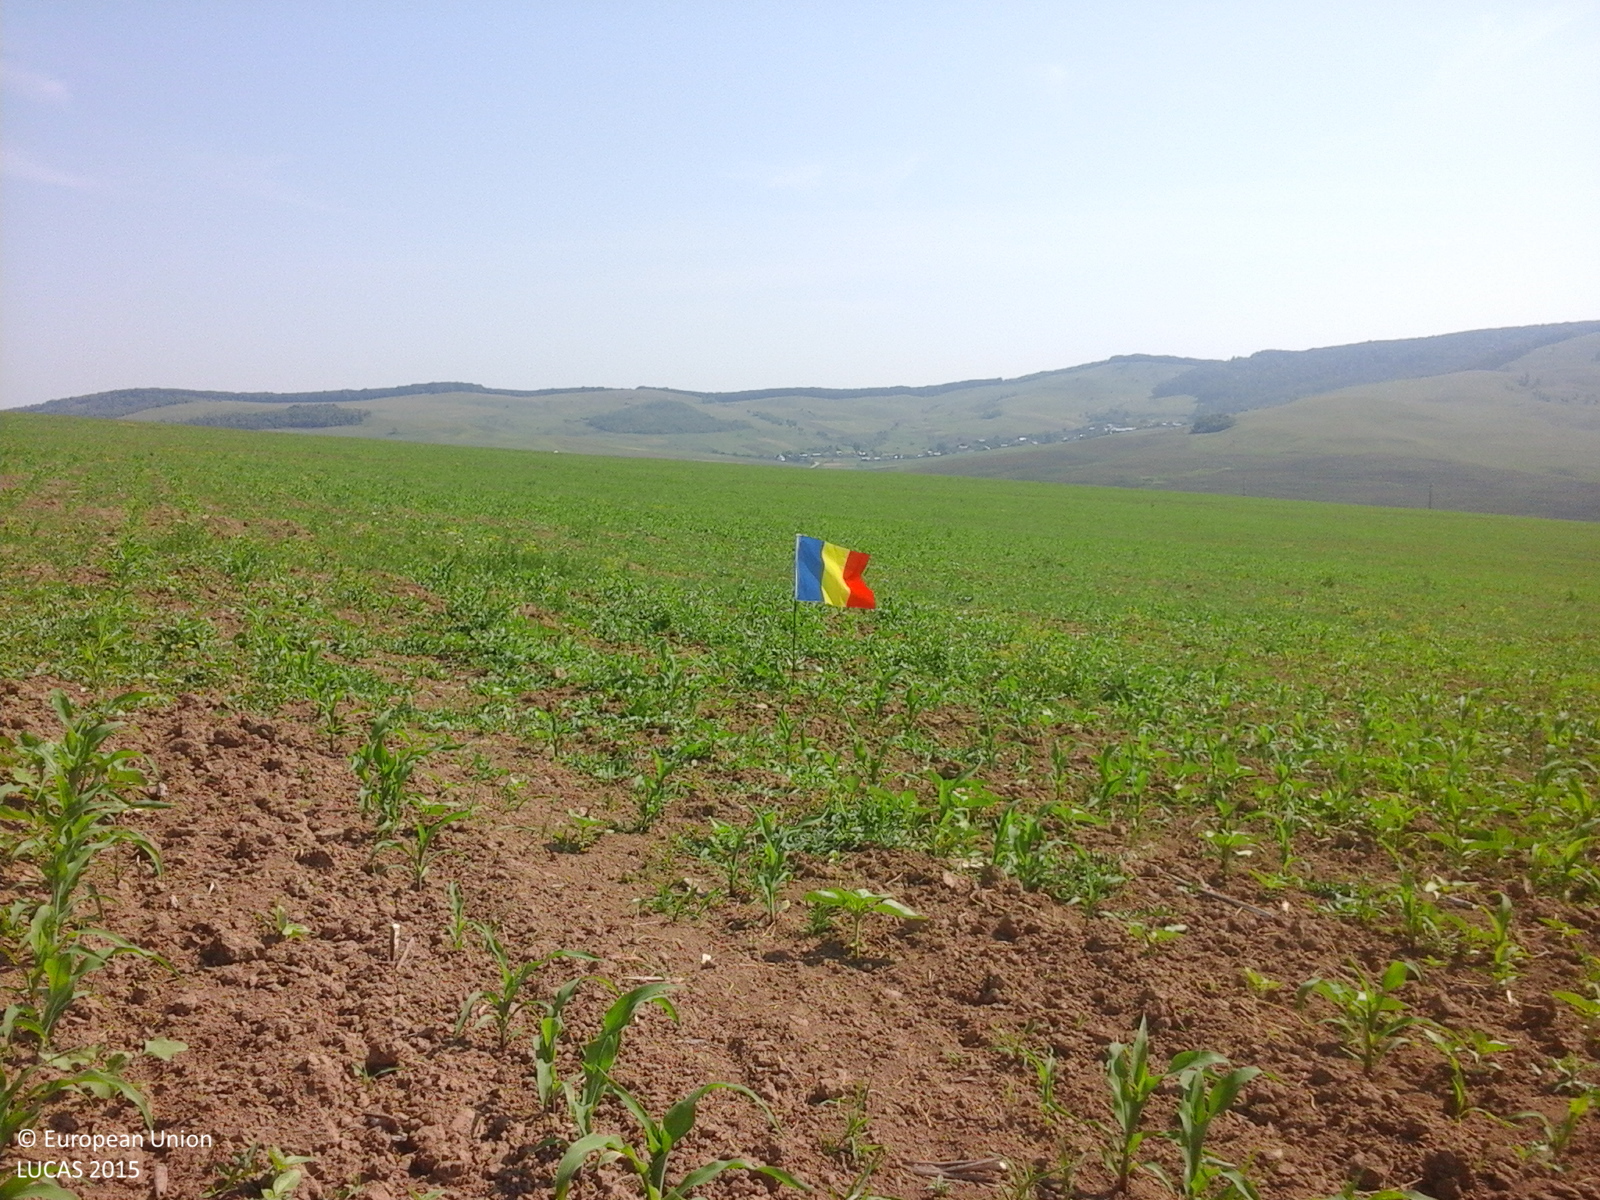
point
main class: Cropland
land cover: Maize
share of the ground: 10 - 25 %
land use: Agriculture (excluding fallow land and kitchen gardens)
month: June
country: RO
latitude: 46.5793
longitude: 27.1026
